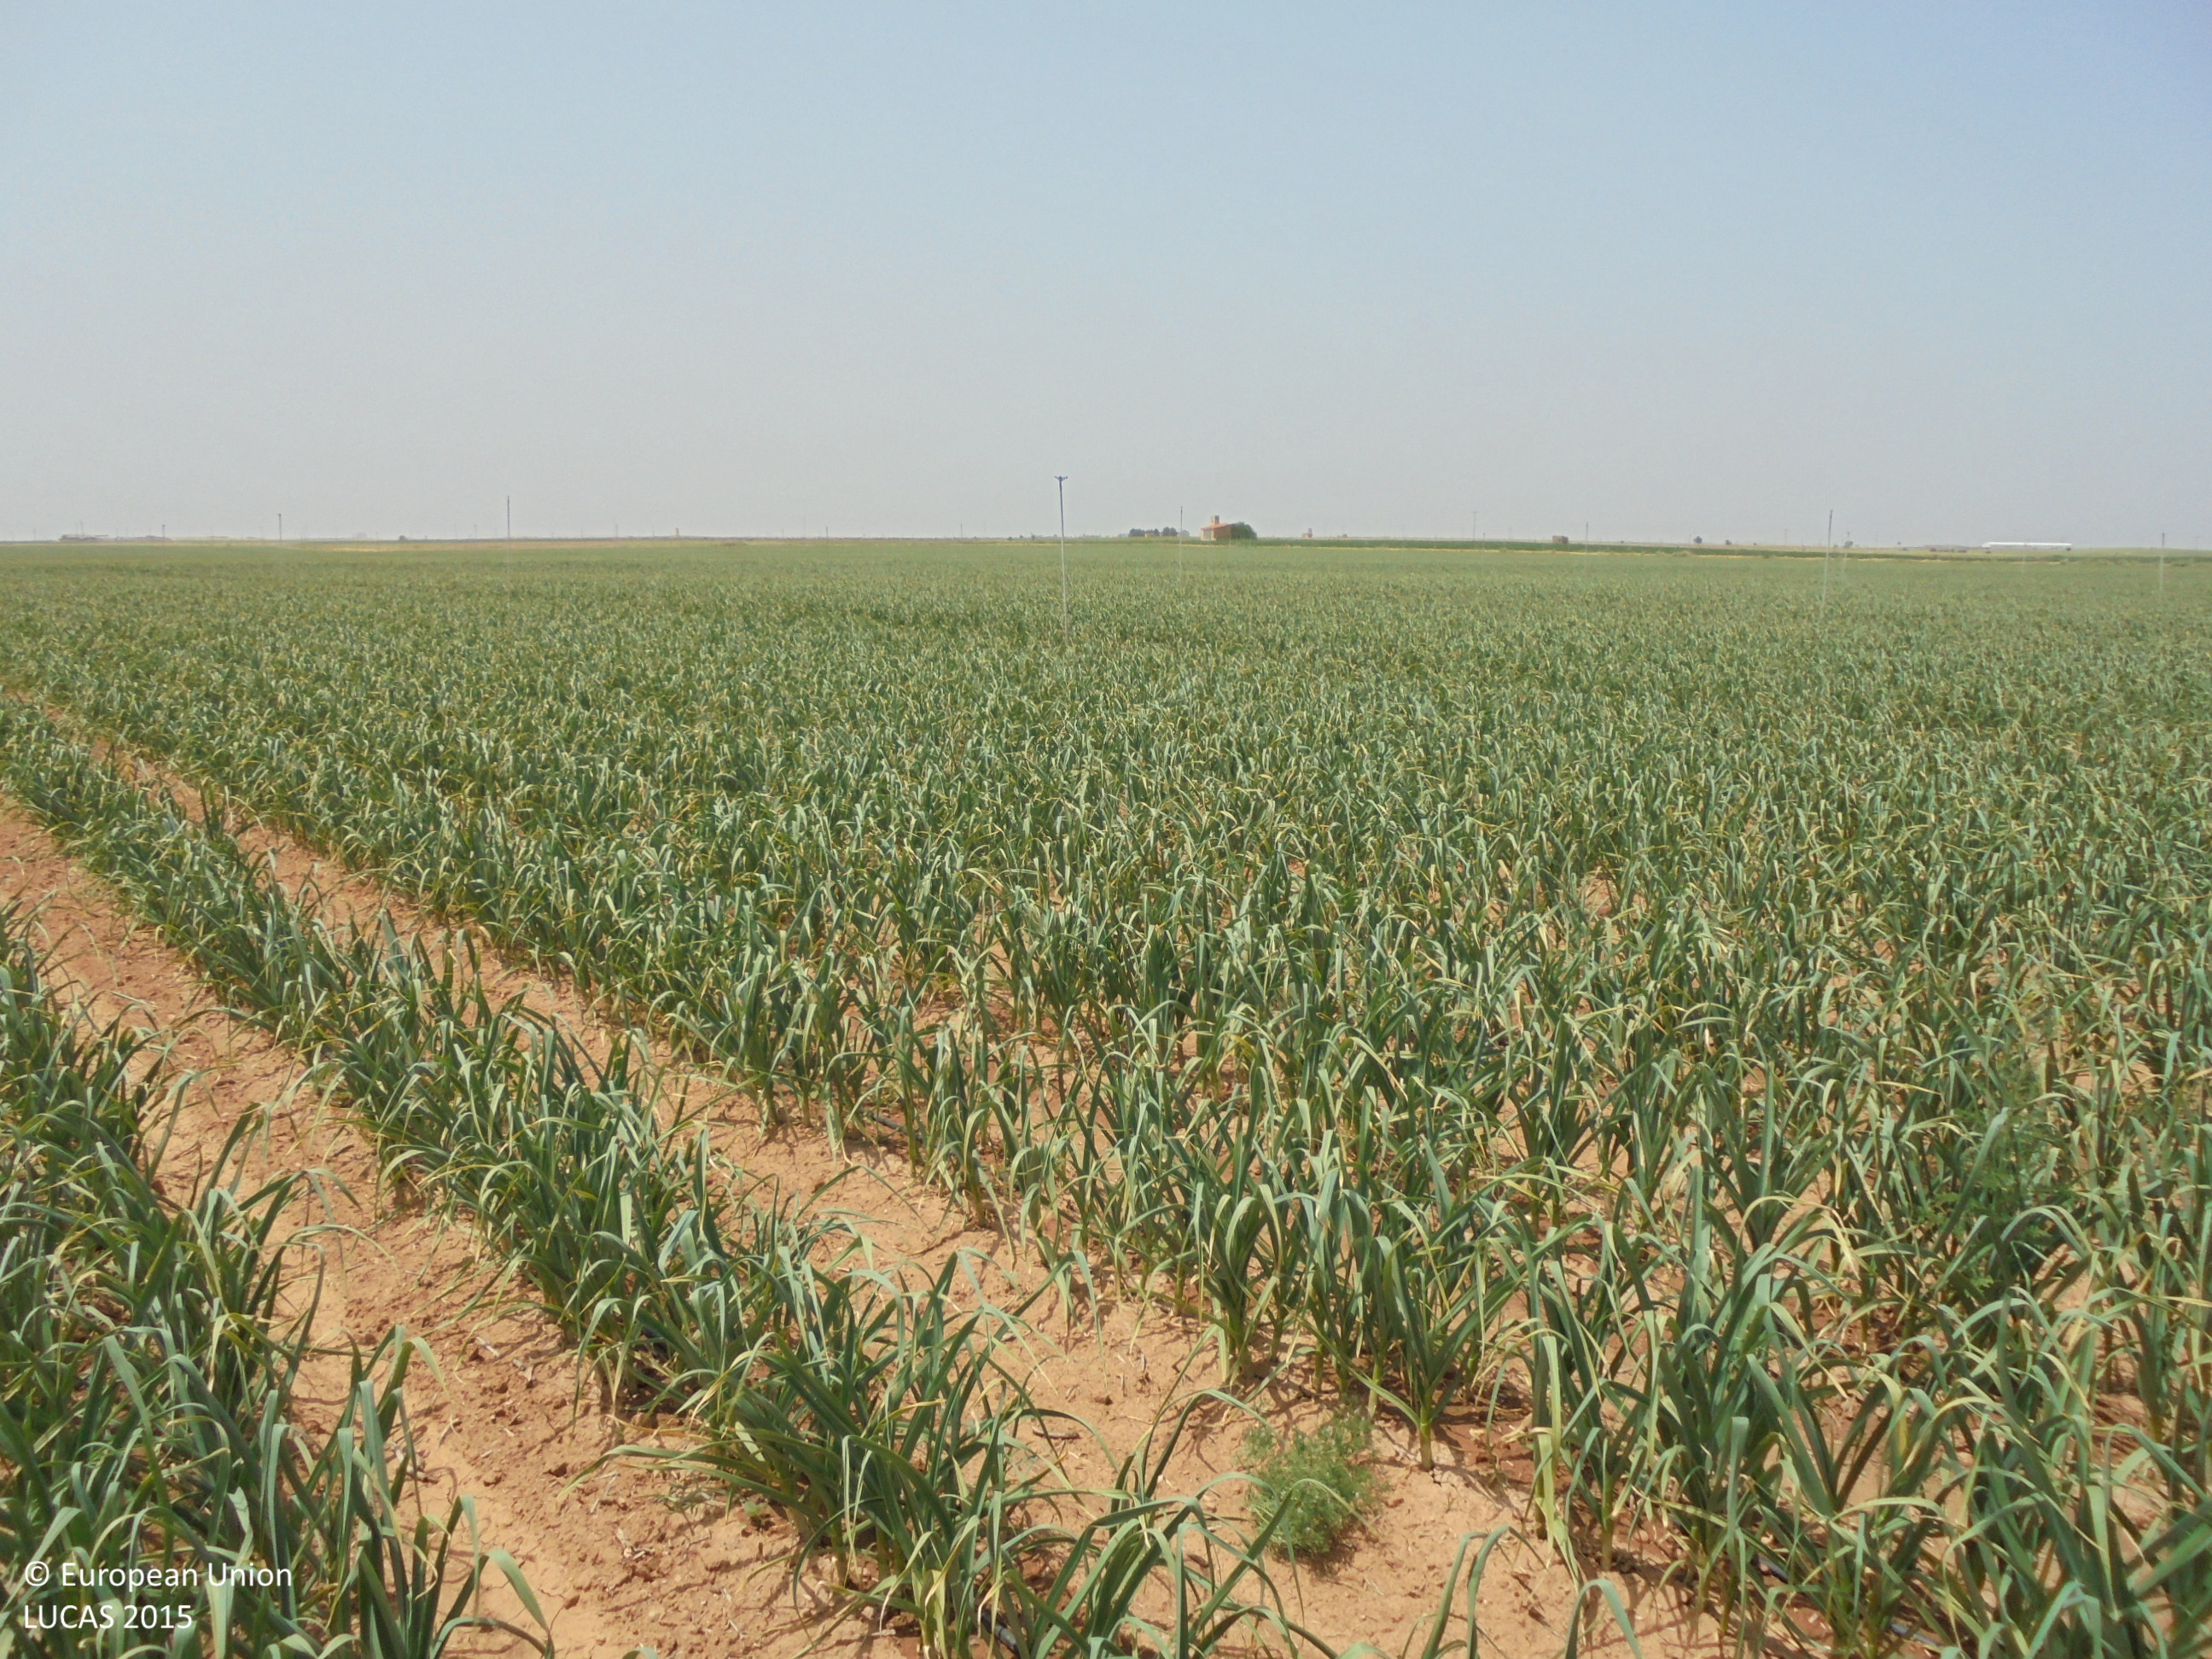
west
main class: Cropland
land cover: Other root crops
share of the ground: 25 - 50 %
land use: Agriculture (excluding fallow land and kitchen gardens)
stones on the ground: < 10 %
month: May
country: ES
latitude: 39.0855
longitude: -1.7347
